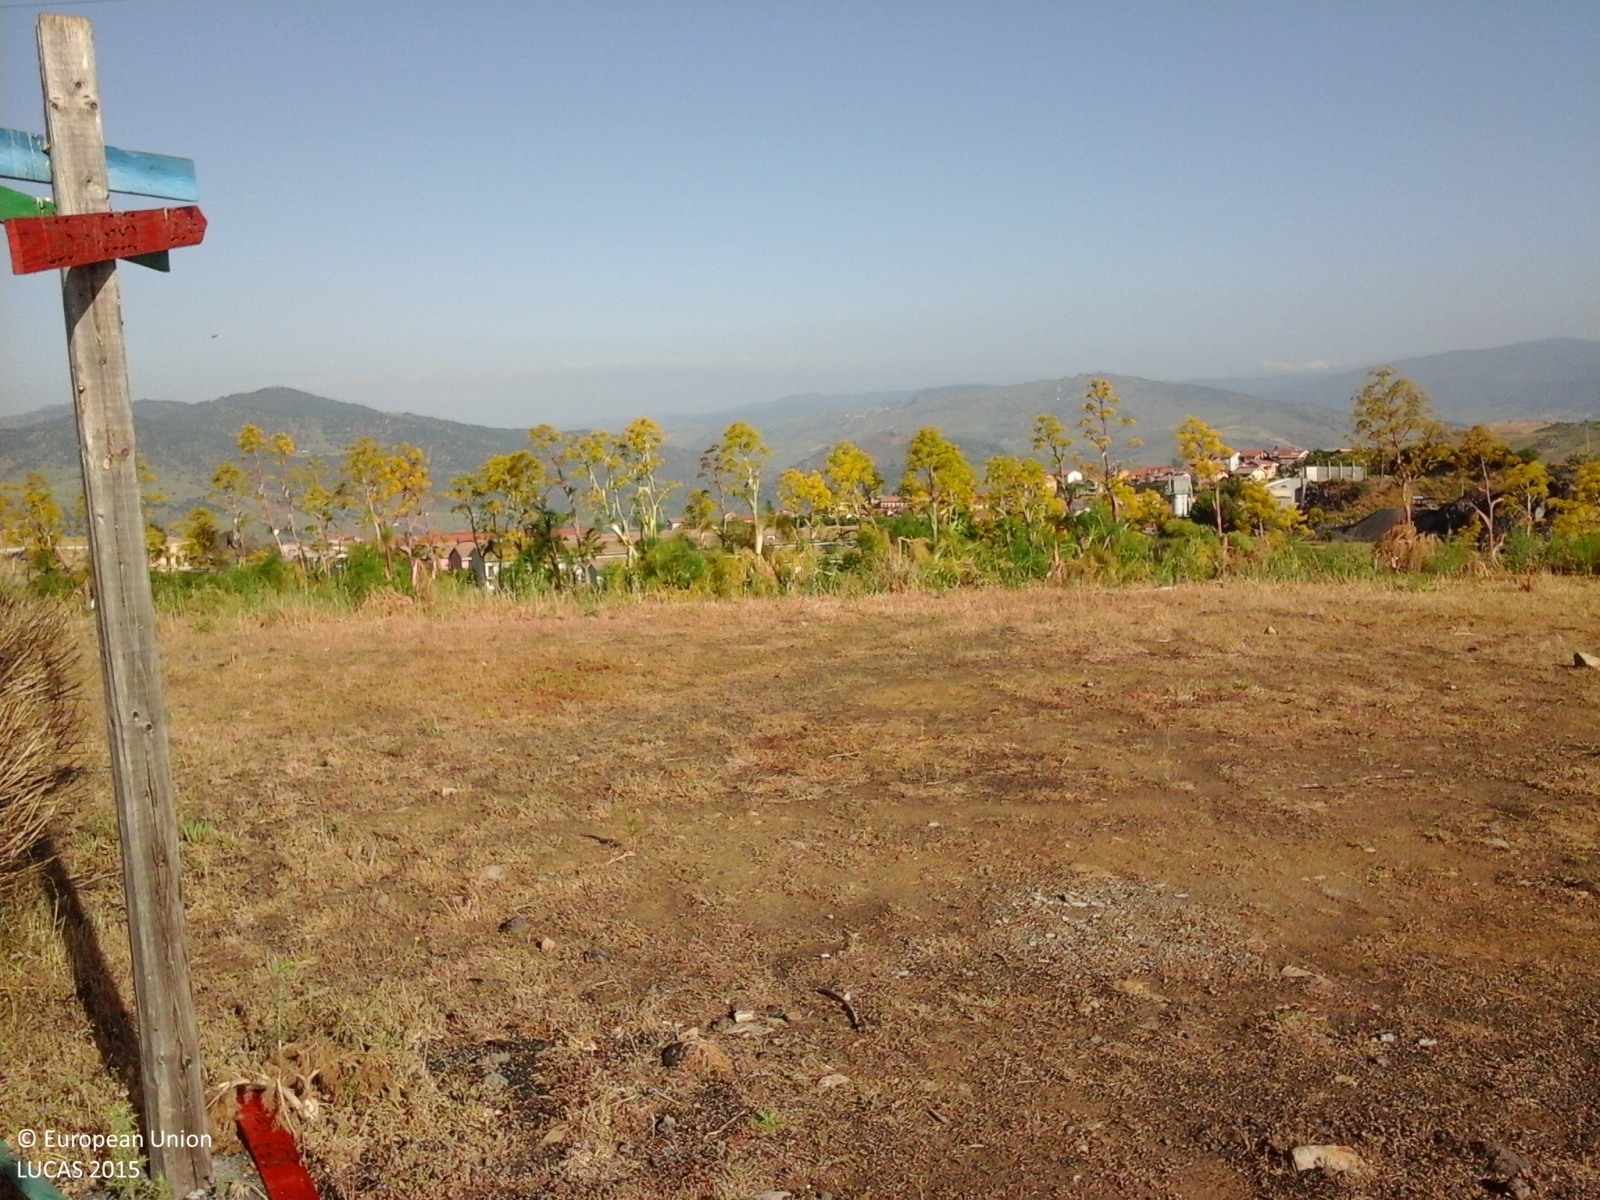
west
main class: Woodland
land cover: Broadleaved woodland
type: thermophilous deciduous forest
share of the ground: > 75 %
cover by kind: broadleaved forest trees 100 %
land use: Forestry
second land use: Amenities, museums, leisure
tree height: > 5 m
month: May
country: IT
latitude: 37.7869
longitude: 14.8604
